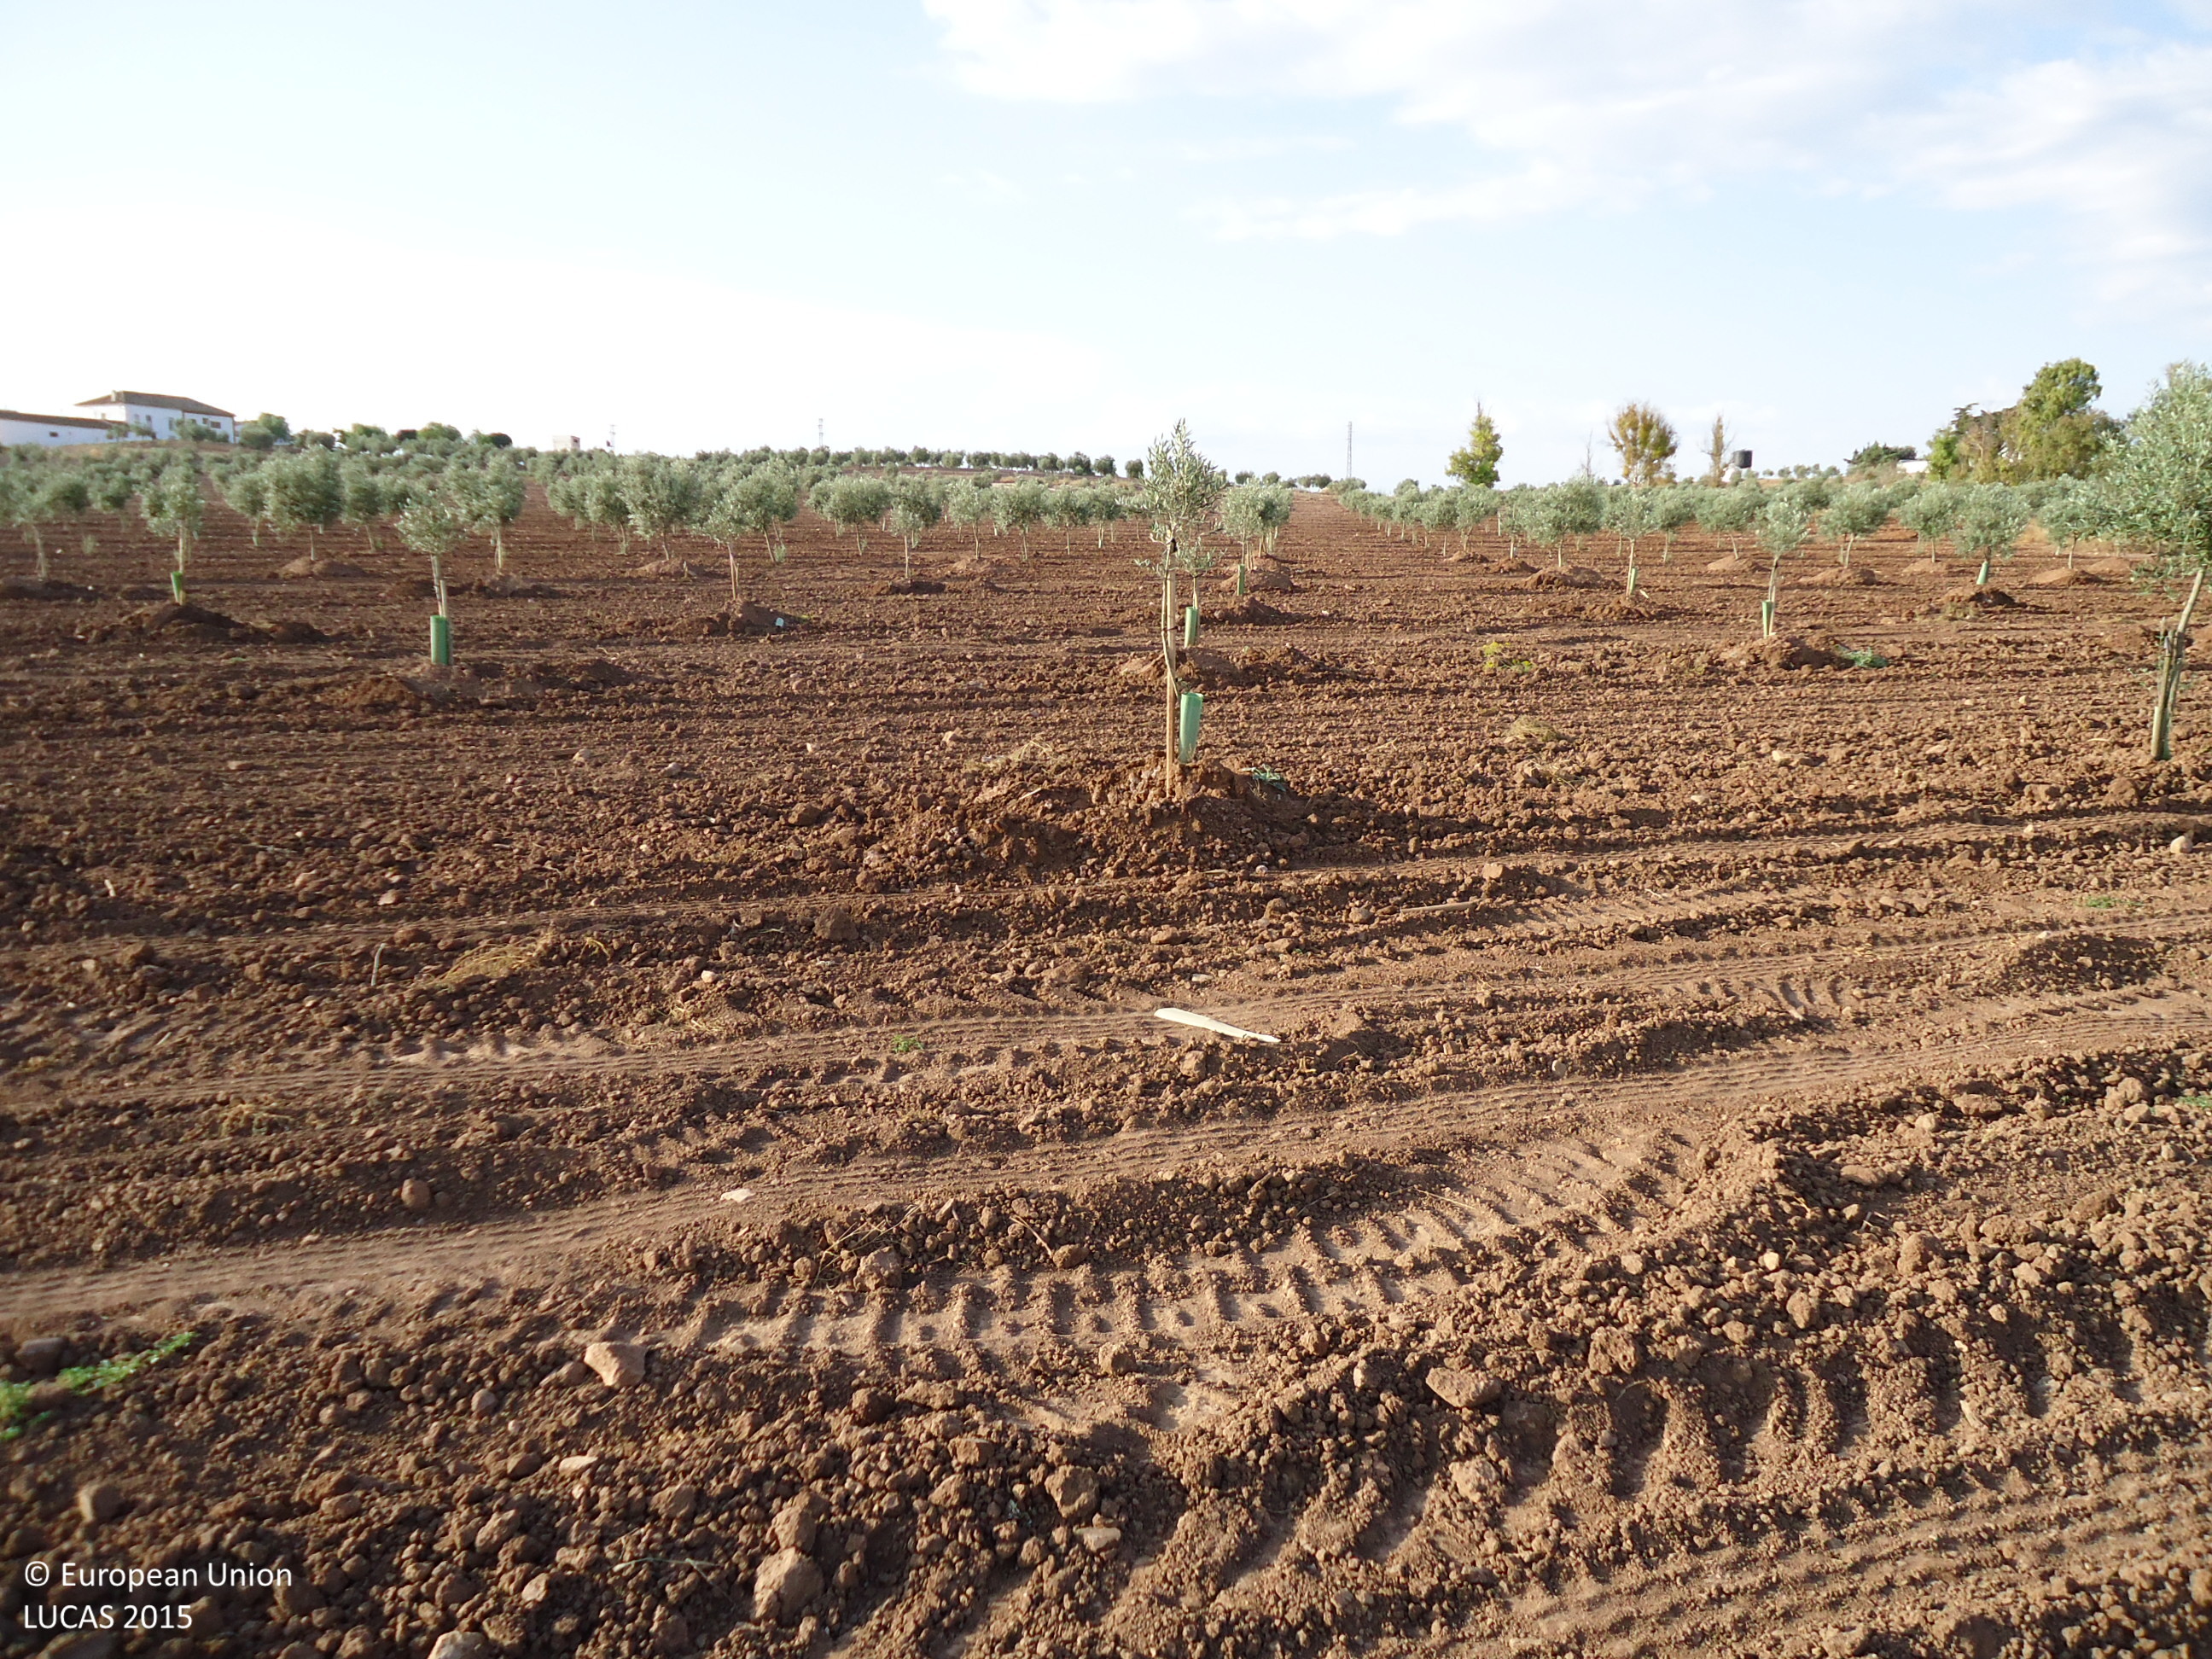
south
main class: Cropland
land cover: Olive groves
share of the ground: 10 - 25 %
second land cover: Other bare soil
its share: > 75 %
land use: Agriculture (excluding fallow land and kitchen gardens)
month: June
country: ES
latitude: 37.0201
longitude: -4.8255
